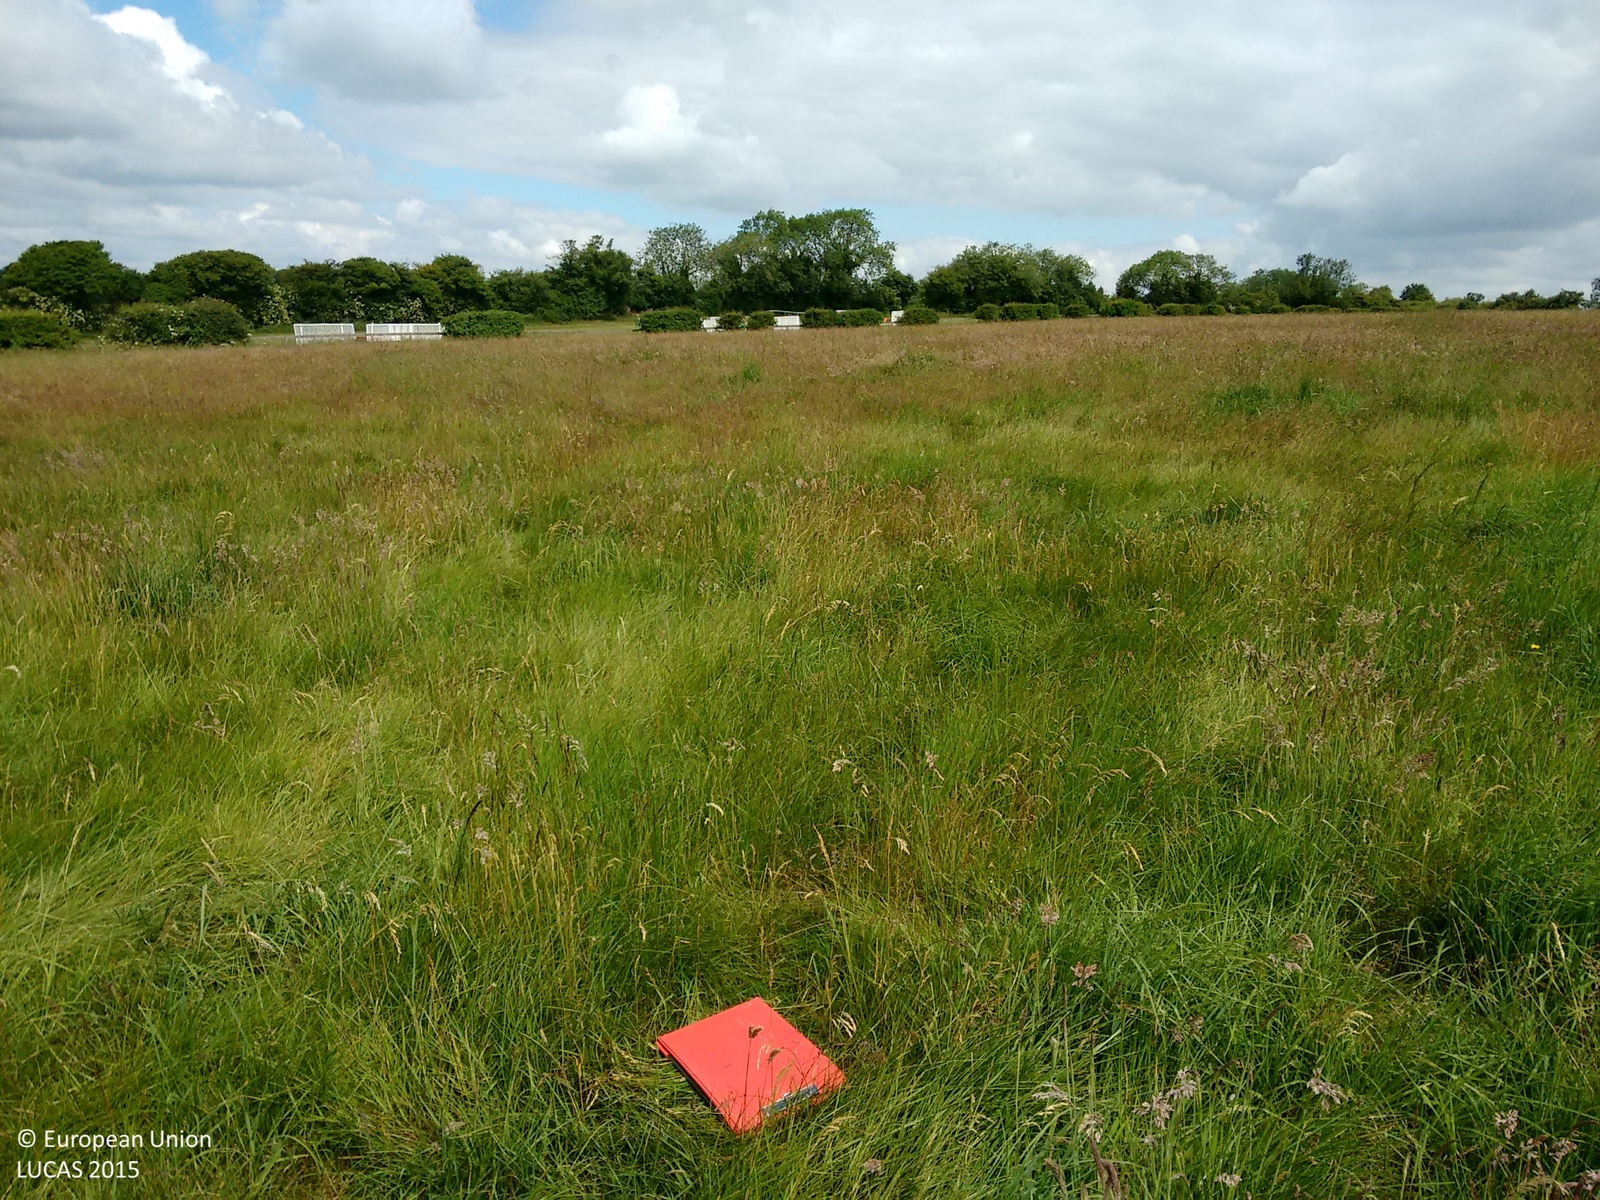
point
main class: Grassland
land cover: Grassland without tree/shrub cover
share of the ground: > 75 %
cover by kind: herbaceous plants 100 %
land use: Agriculture (excluding fallow land and kitchen gardens)
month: June
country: GB
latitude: 51.5220
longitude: -1.5384
